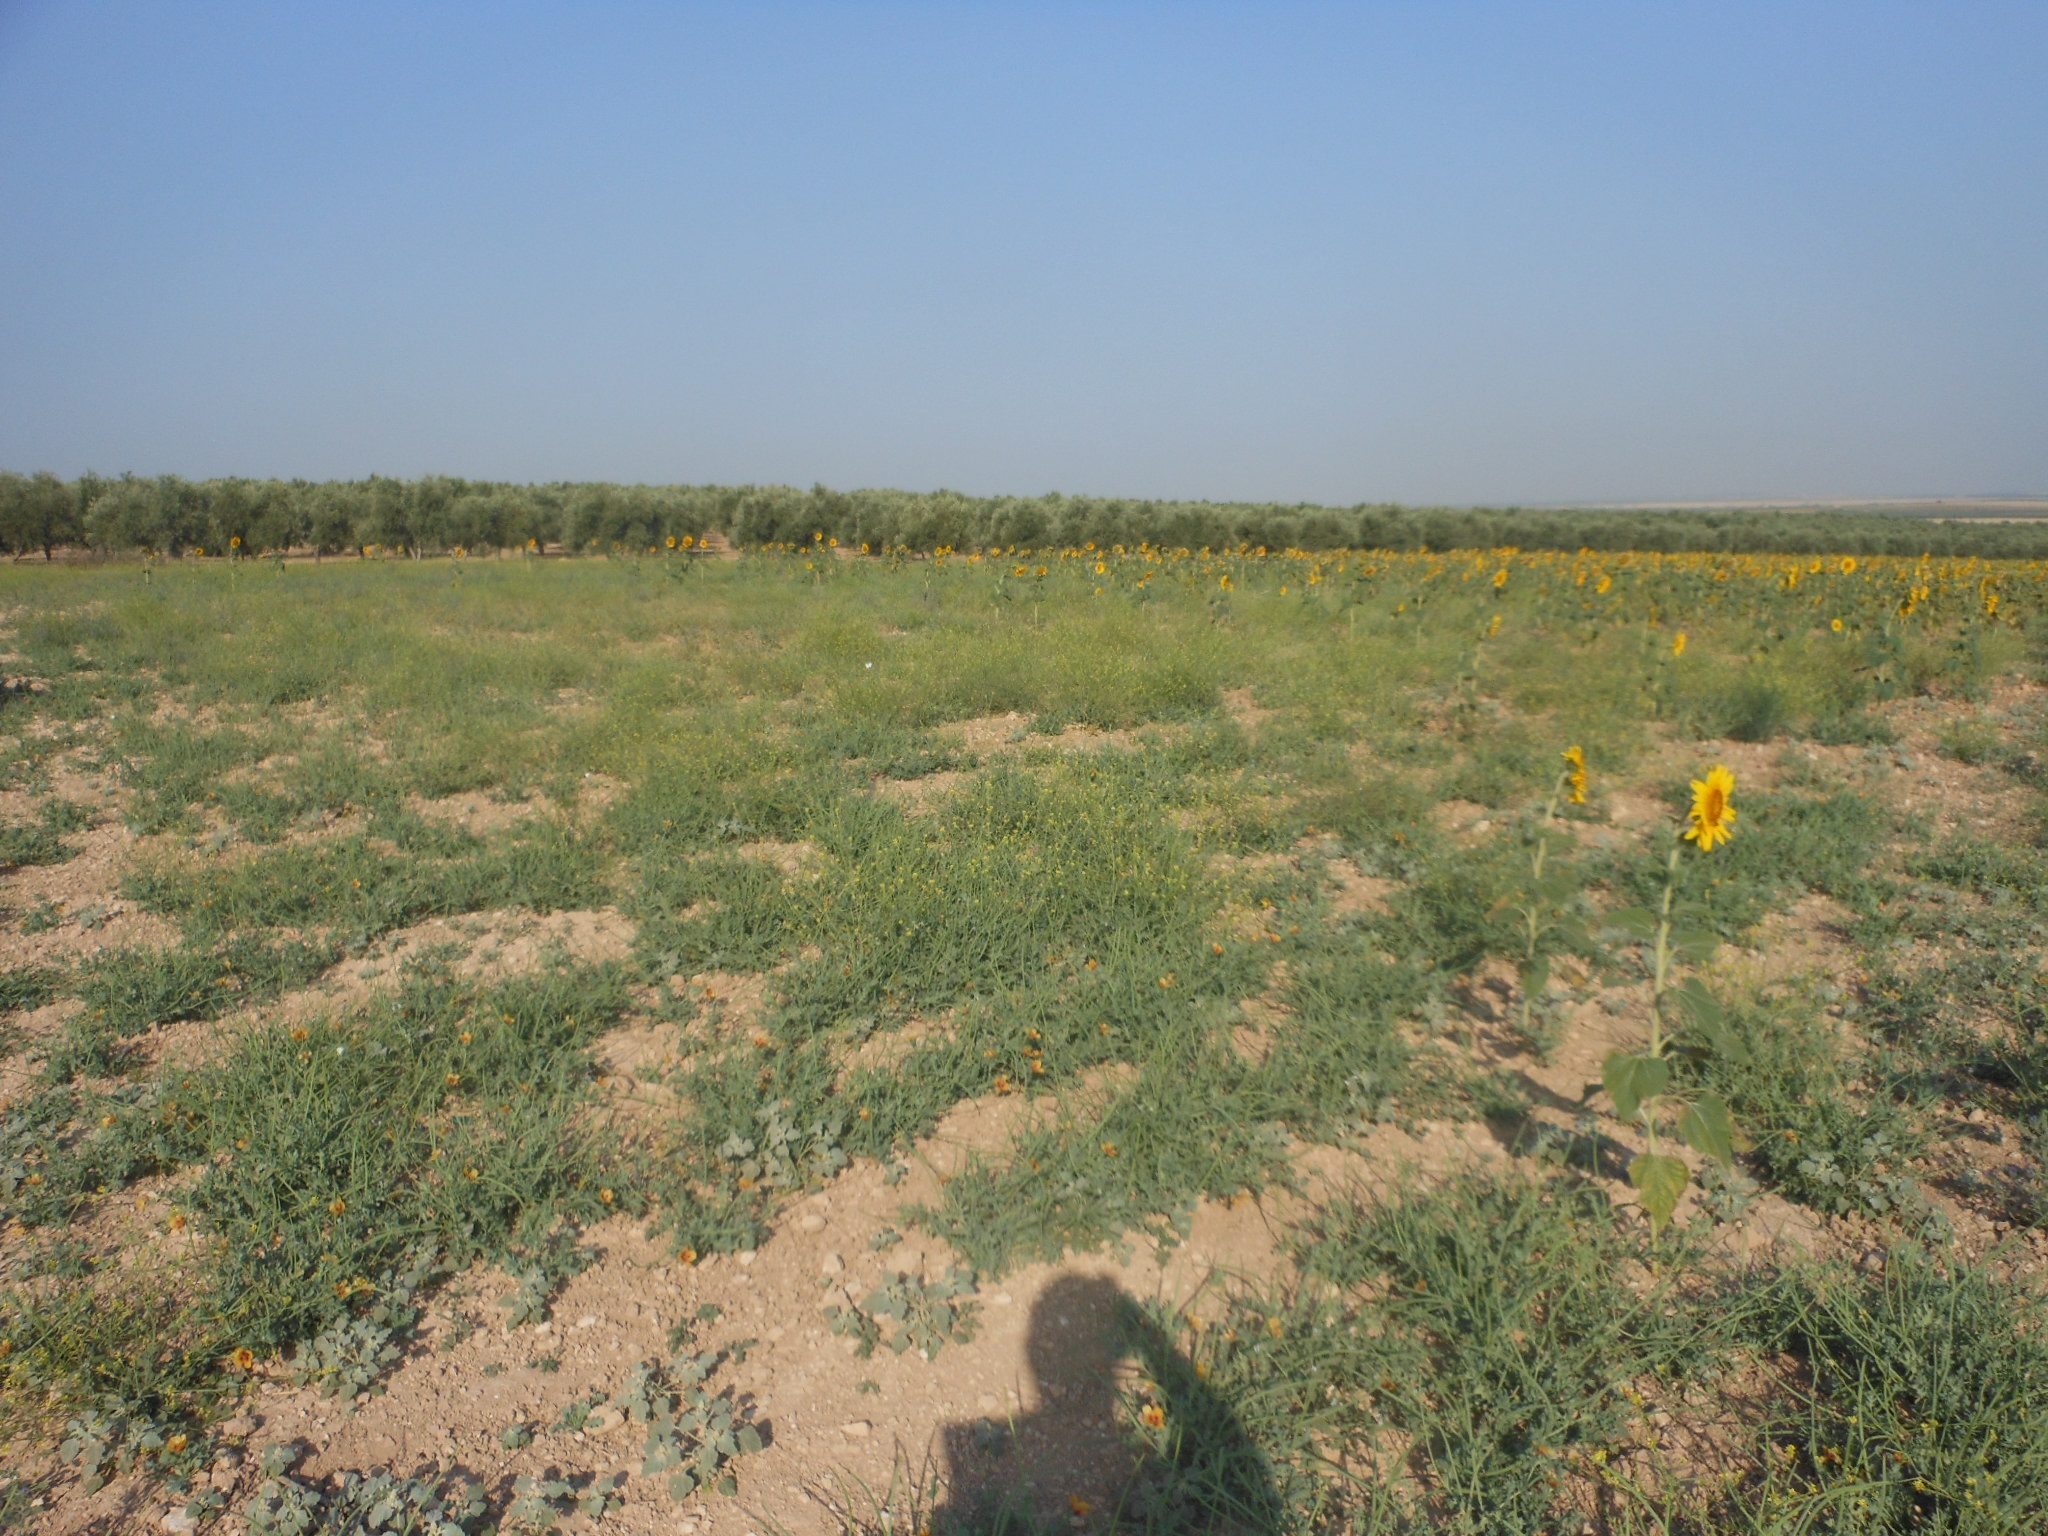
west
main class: Cropland
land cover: Sunflower
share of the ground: 25 - 50 %
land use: Agriculture (excluding fallow land and kitchen gardens)
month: June
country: ES
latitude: 37.2942
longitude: -5.0677
